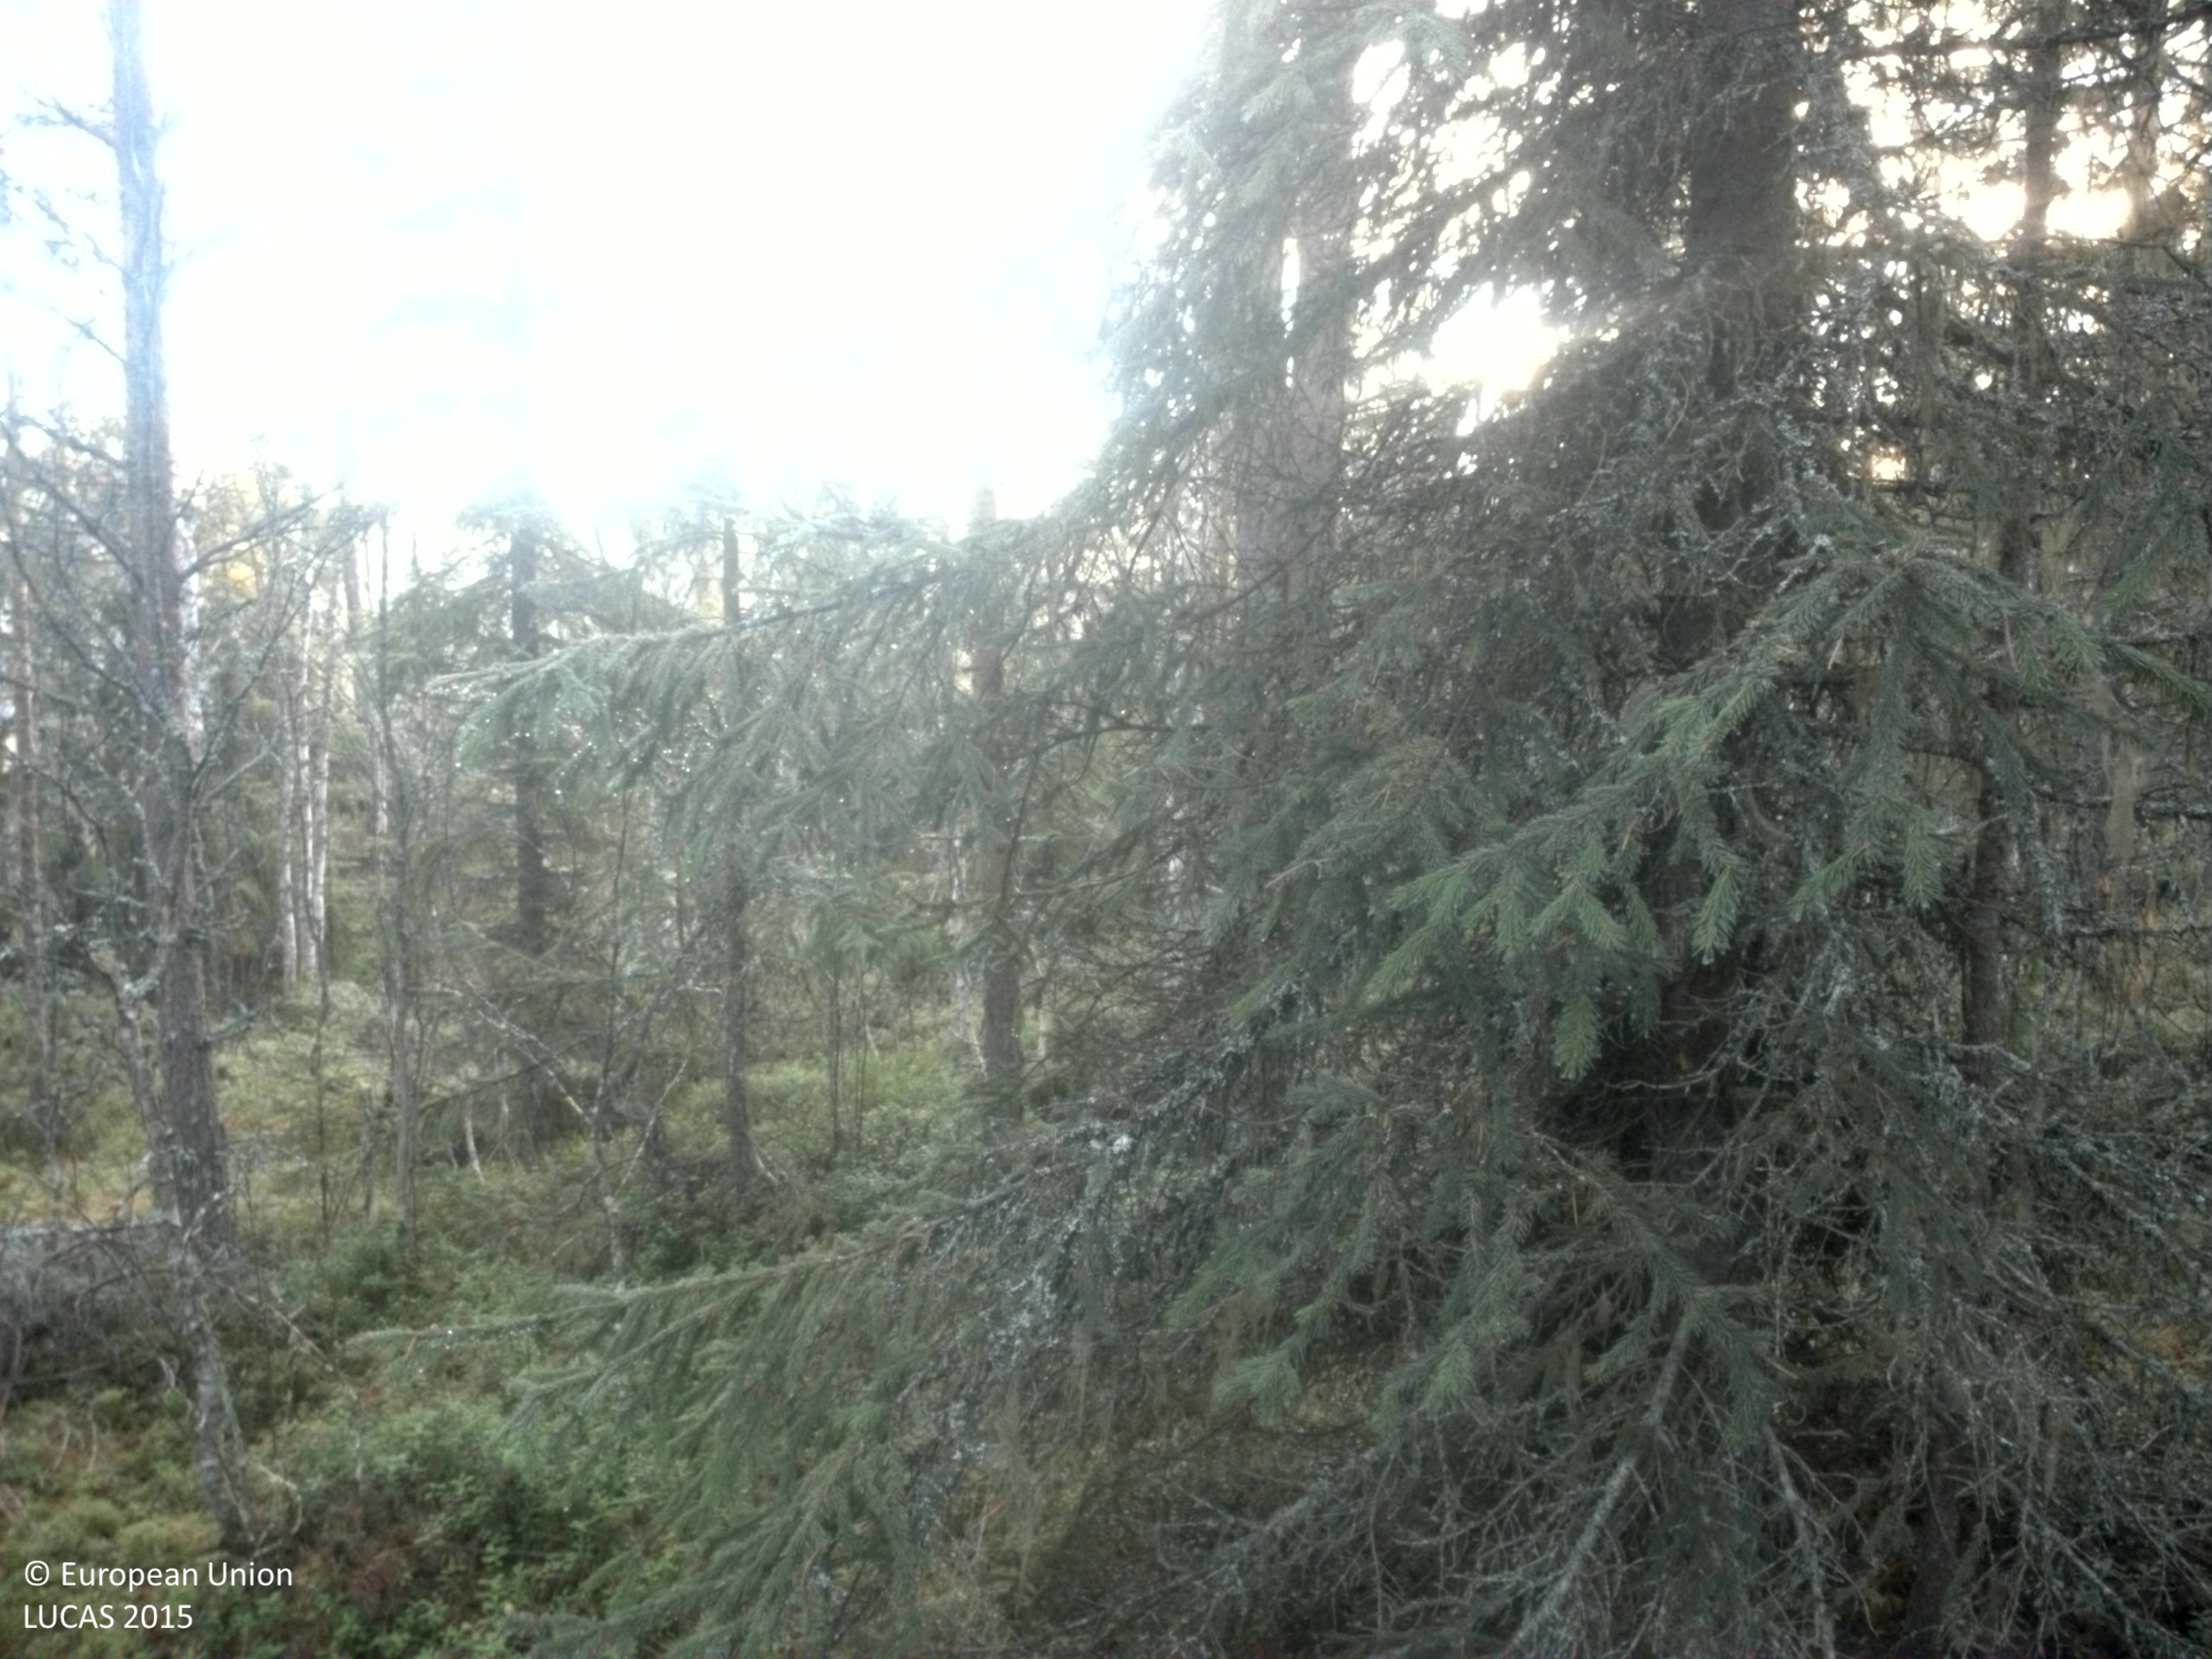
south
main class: Woodland
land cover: Other mixed woodland
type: boreal forest
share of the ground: 50 - 75 %
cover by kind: coniferous forest trees 35 %, shrubs 25 %, broadleaved forest trees 20 %, lichens and mosses 15 %, herbaceous plants 5 %
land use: Forestry
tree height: > 5 m
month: November
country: SE
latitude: 63.8886
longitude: 15.9392
